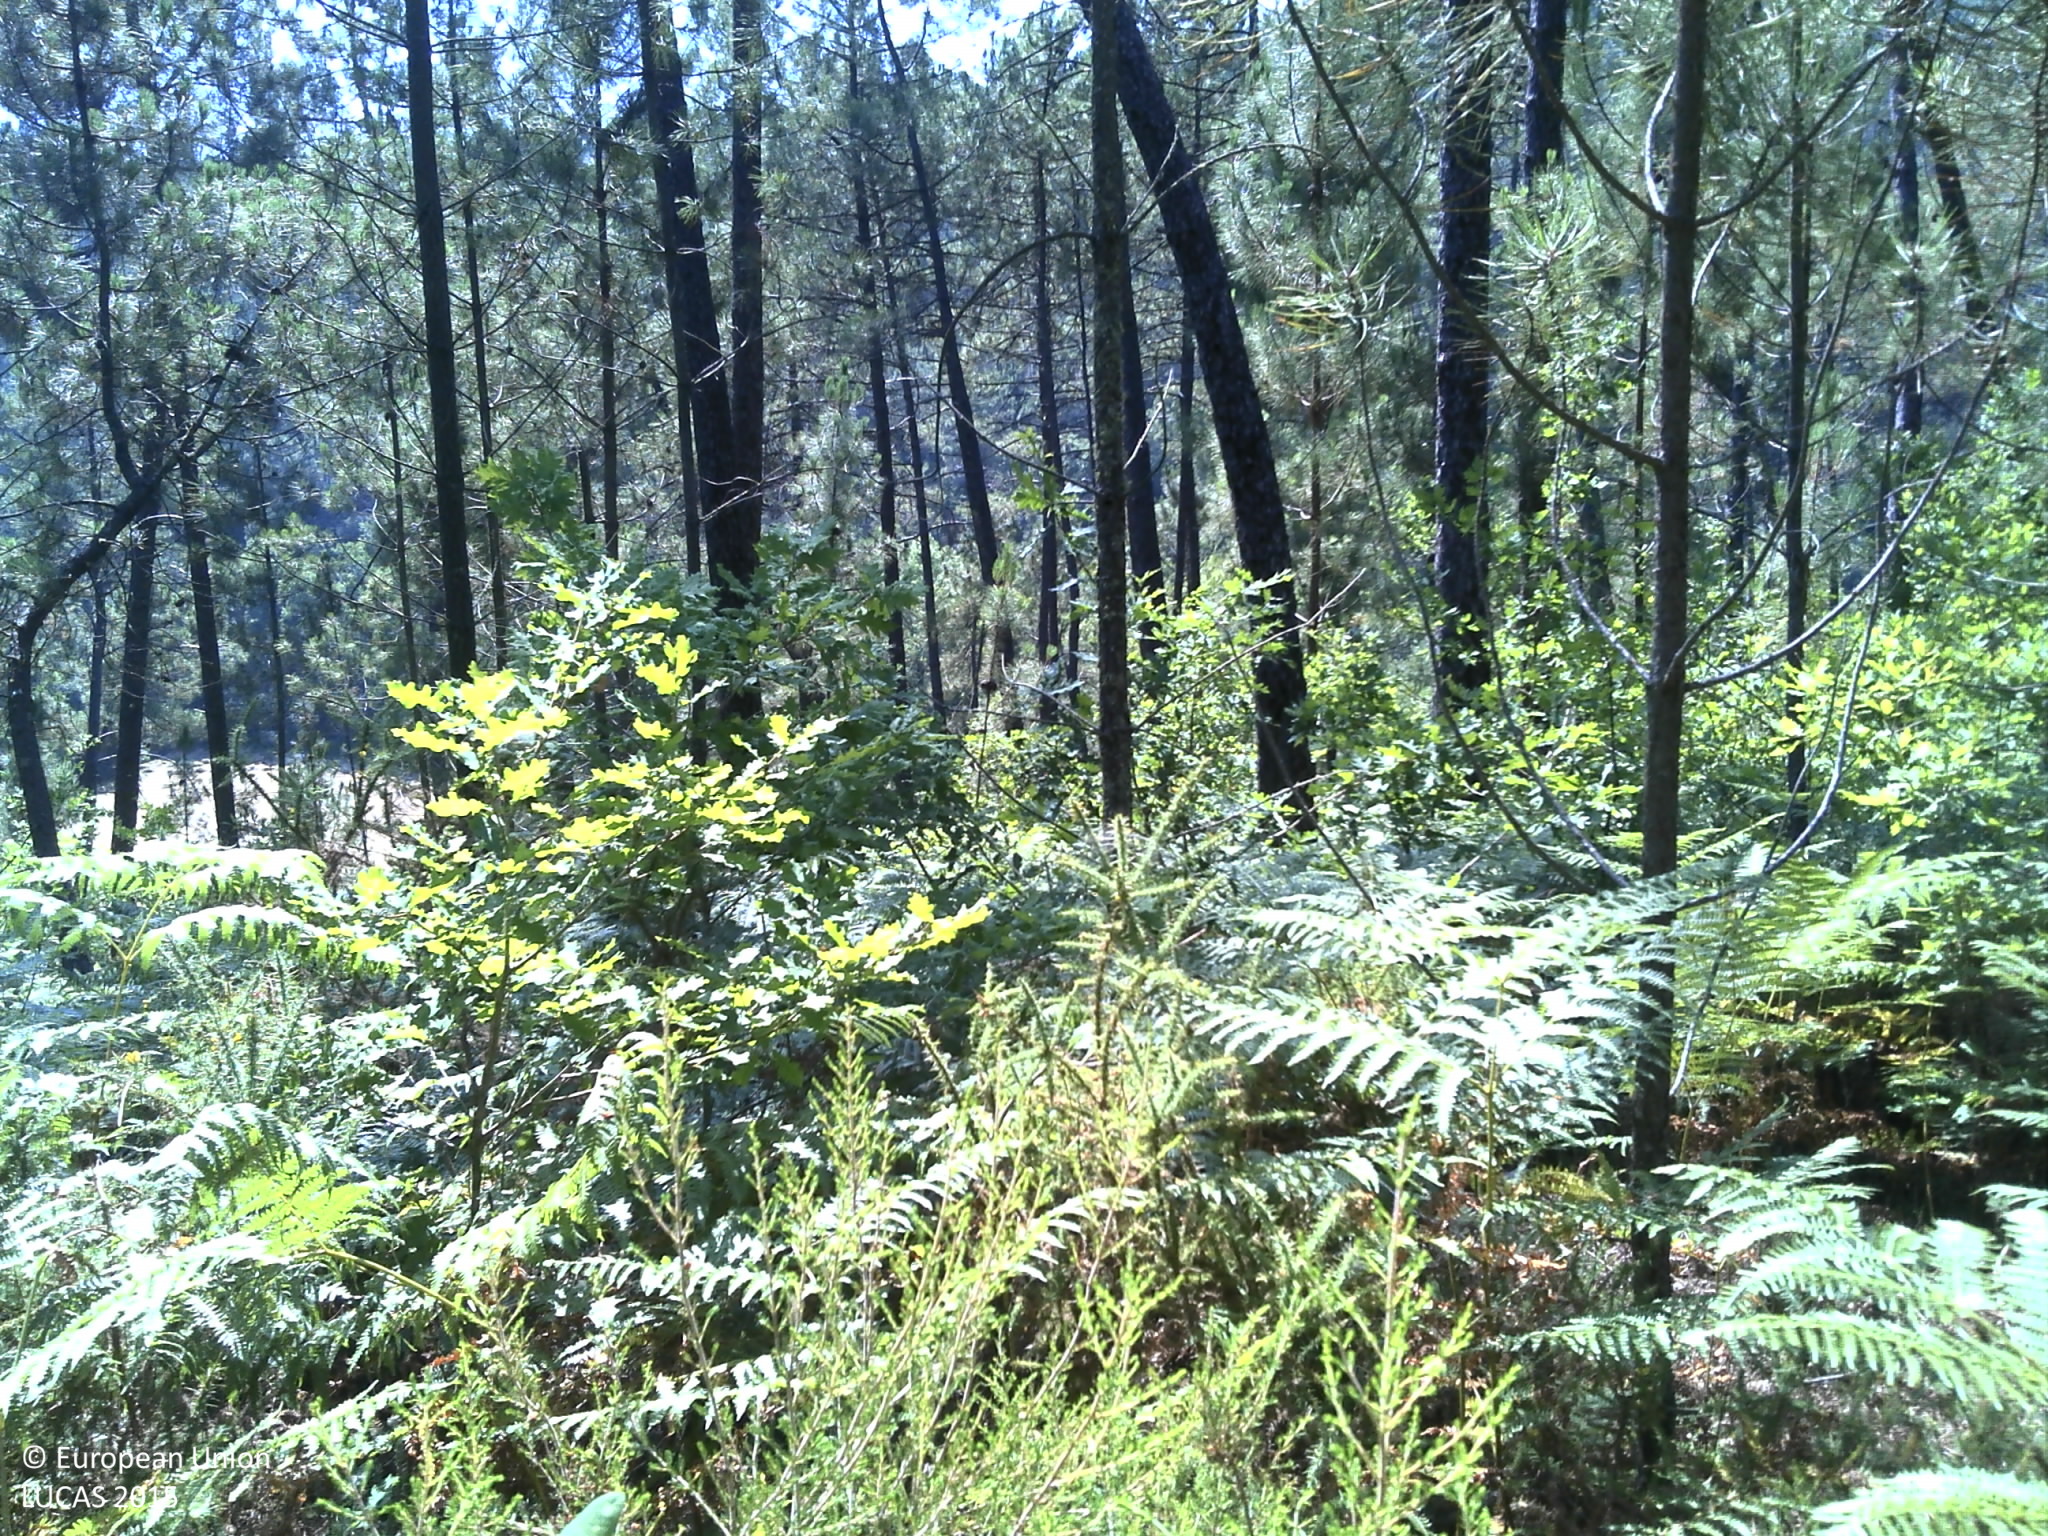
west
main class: Woodland
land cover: Pine dominated coniferous woodland
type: coniferous forest of the mediterranean region
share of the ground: 10 - 25 %
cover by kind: shrubs 85 %, coniferous forest trees 15 %
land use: Forestry
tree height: > 5 m
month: July
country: PT
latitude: 40.9143
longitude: -7.9025
